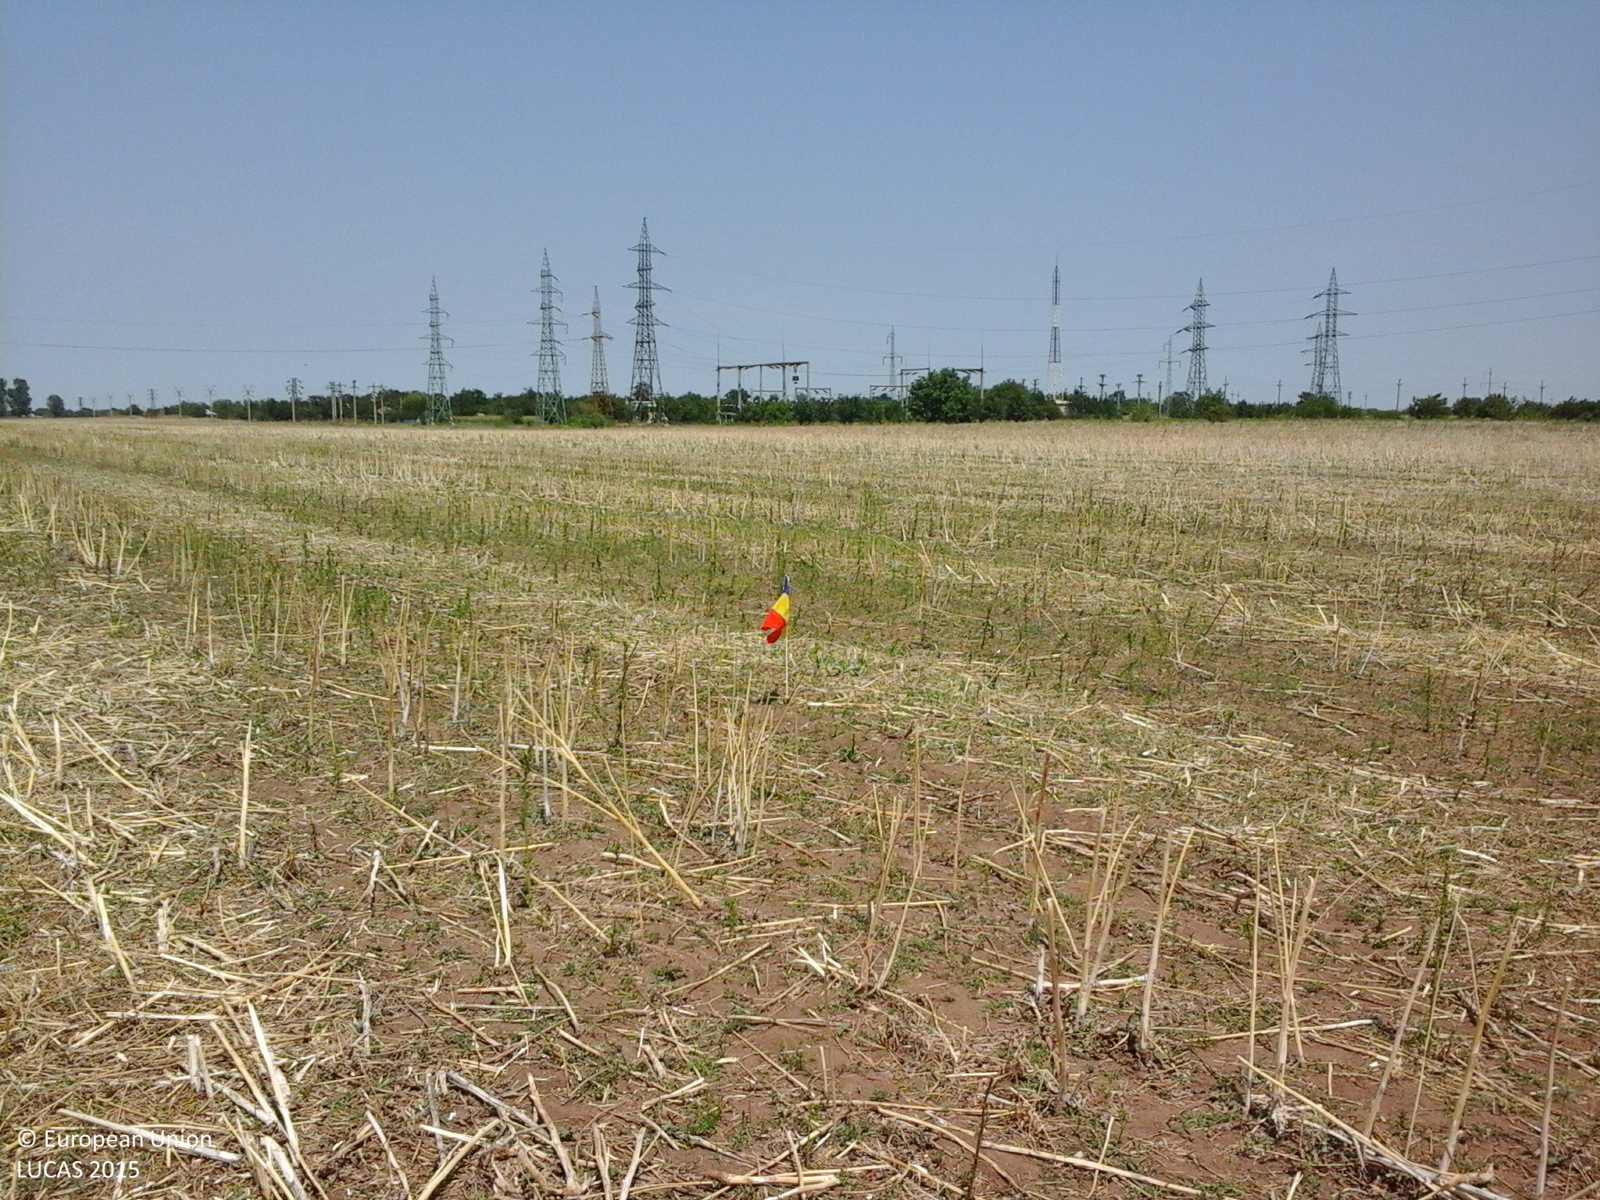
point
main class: Cropland
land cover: Rape and turnip rape
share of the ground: 10 - 25 %
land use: Agriculture (excluding fallow land and kitchen gardens)
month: July
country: RO
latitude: 44.9344
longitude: 27.2598
